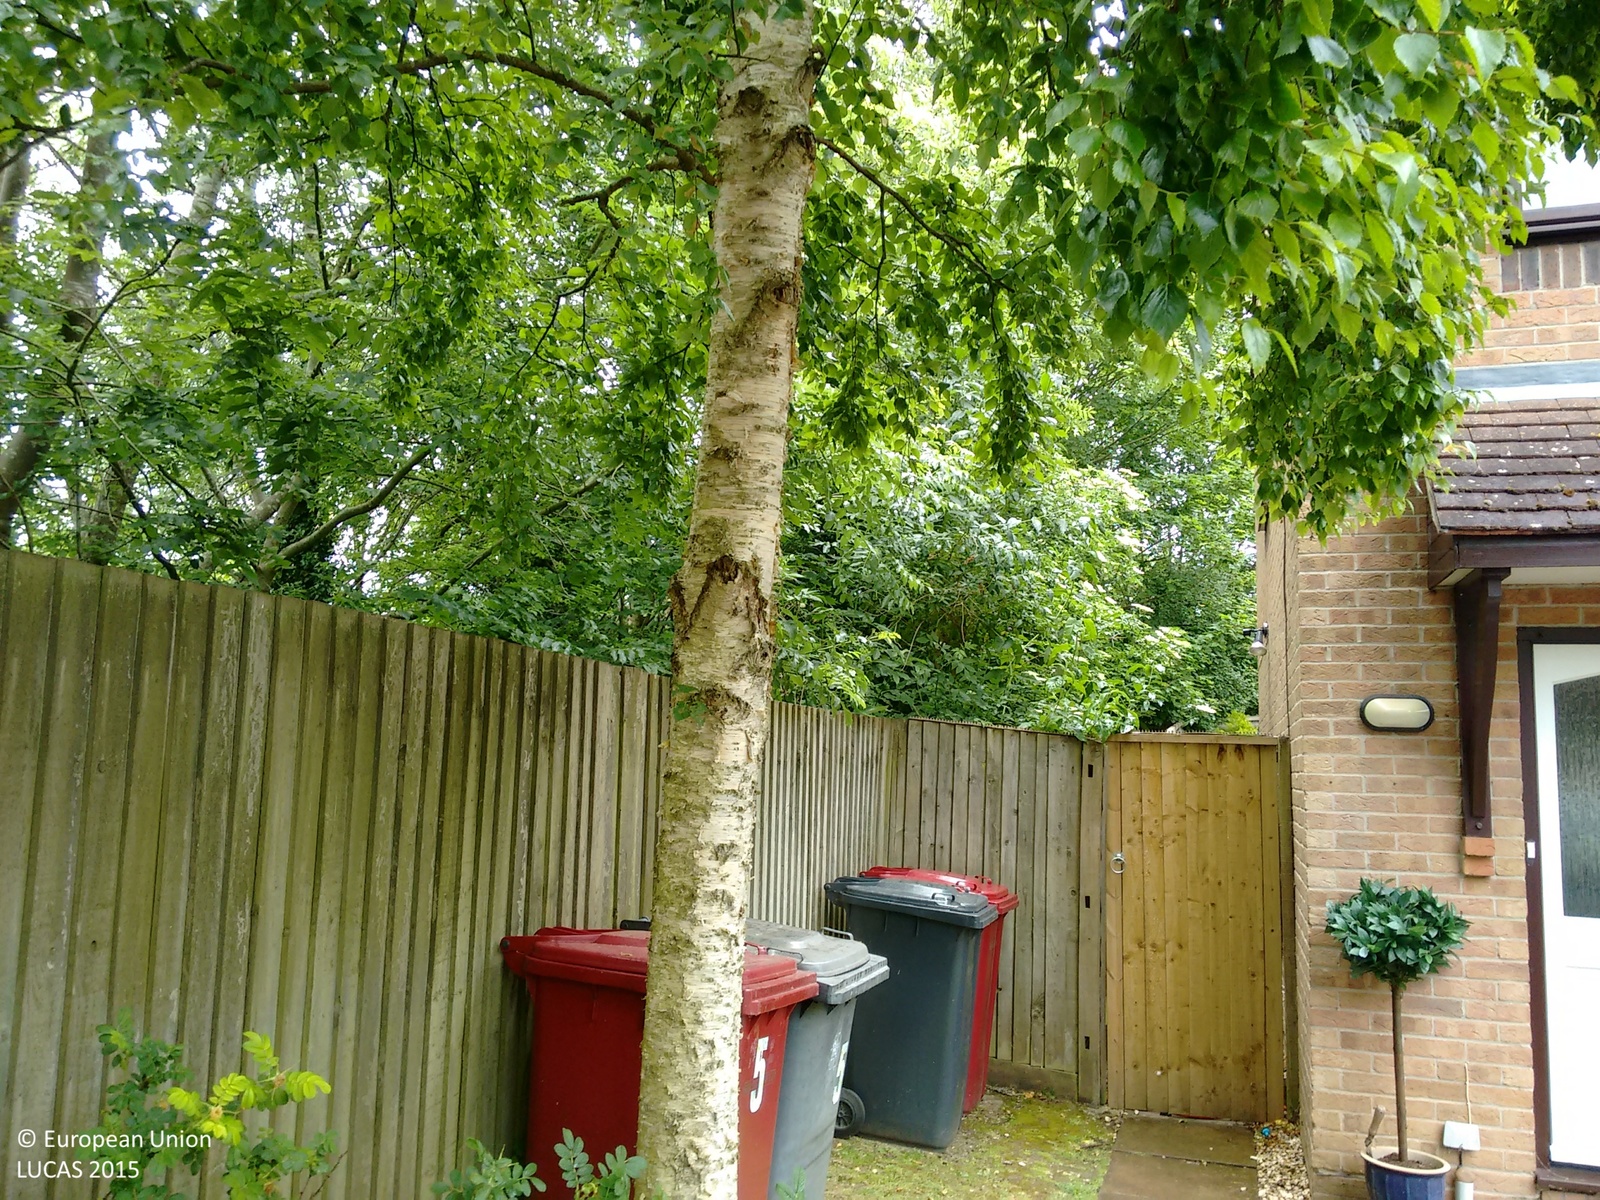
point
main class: Woodland
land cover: Broadleaved woodland
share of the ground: > 75 %
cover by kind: broadleaved forest trees 70 %, herbaceous plants 30 %
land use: Residential
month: June
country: GB
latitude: 51.4627
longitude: -1.0272
